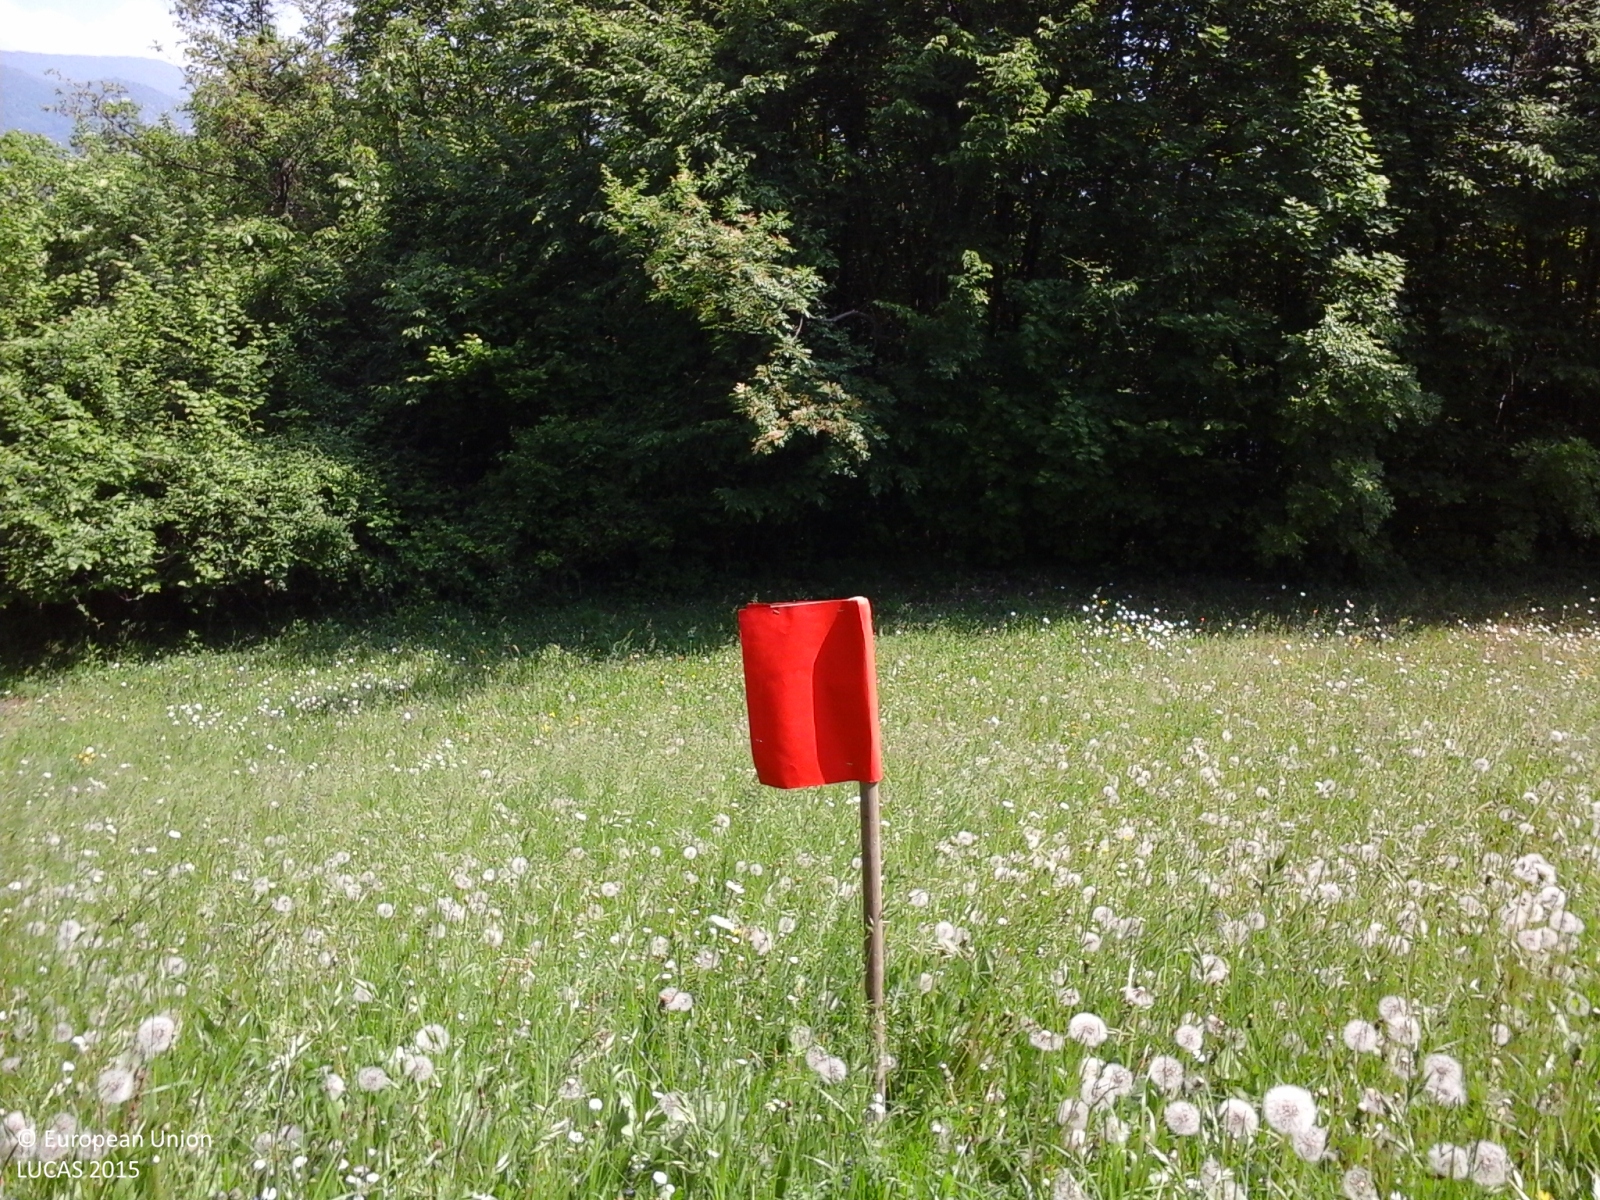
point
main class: Grassland
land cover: Grassland without tree/shrub cover
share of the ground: > 75 %
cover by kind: herbaceous plants 100 %
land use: Agriculture (excluding fallow land and kitchen gardens)
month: May
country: IT
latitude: 44.8177
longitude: 9.4069
